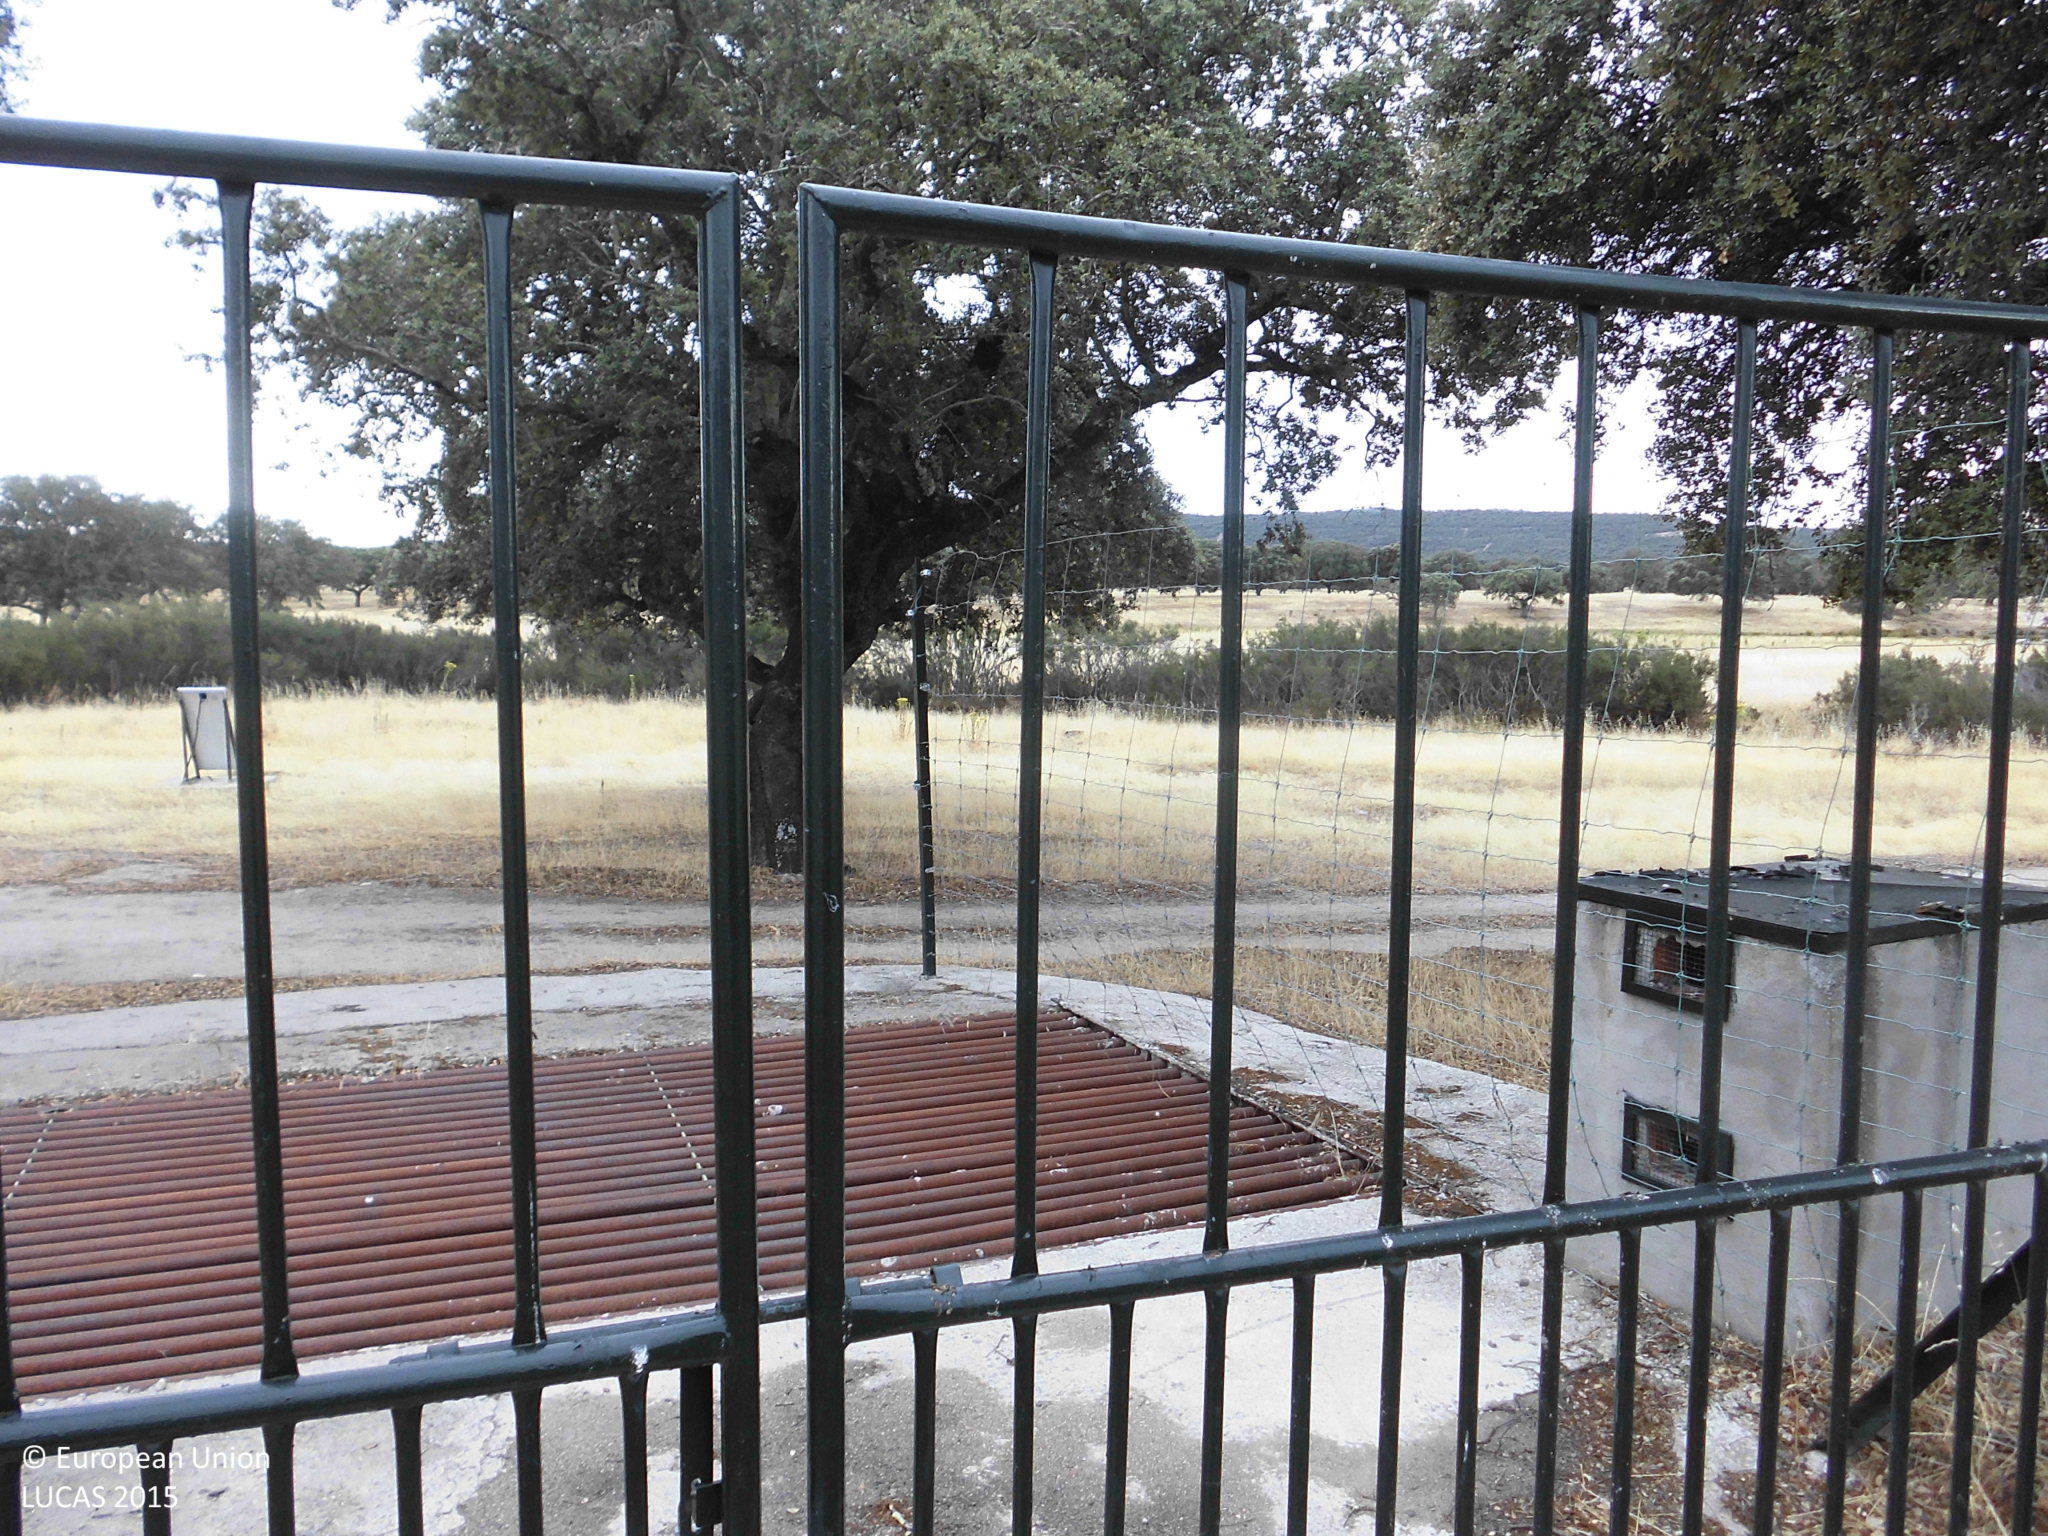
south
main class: Woodland
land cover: Broadleaved woodland
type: broadleaved evergreen forest
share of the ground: 25 - 50 %
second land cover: Grassland without tree/shrub cover
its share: > 75 %
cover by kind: herbaceous plants 55 %, broadleaved forest trees 45 %
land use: Forestry
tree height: > 5 m
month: July
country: ES
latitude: 39.8464
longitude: -6.5450
